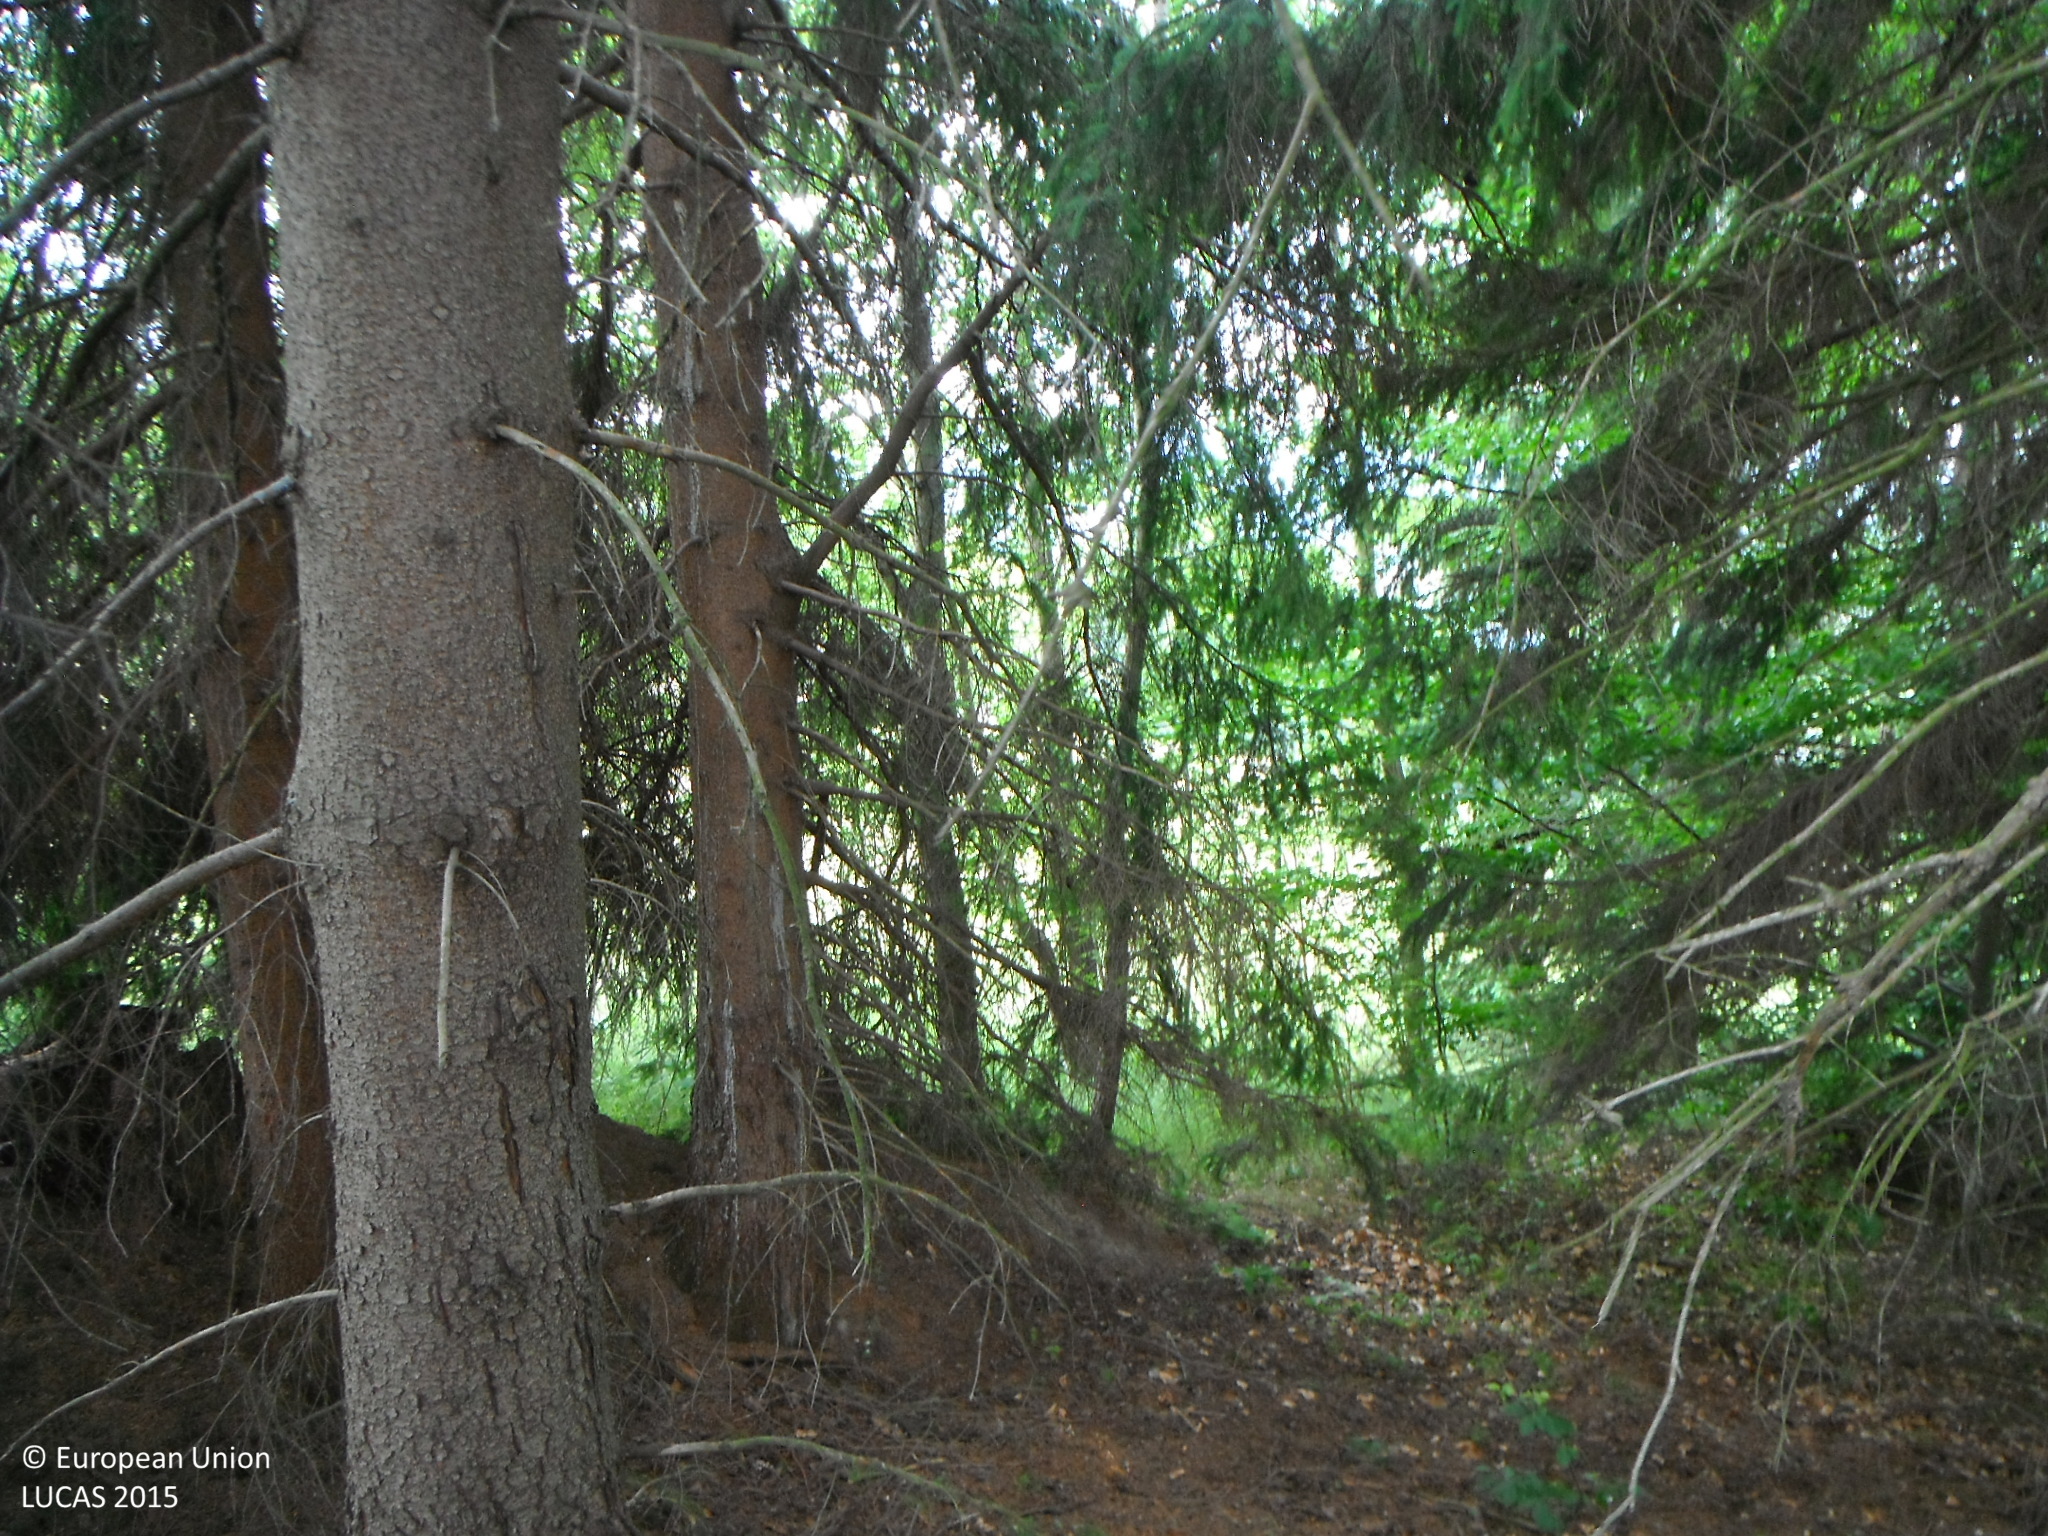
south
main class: Woodland
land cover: Spruce dominated coniferous woodland
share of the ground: > 75 %
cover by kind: coniferous forest trees 90 %, broadleaved forest trees 10 %
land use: Forestry
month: July
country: SK
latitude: 49.4074
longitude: 19.2722
